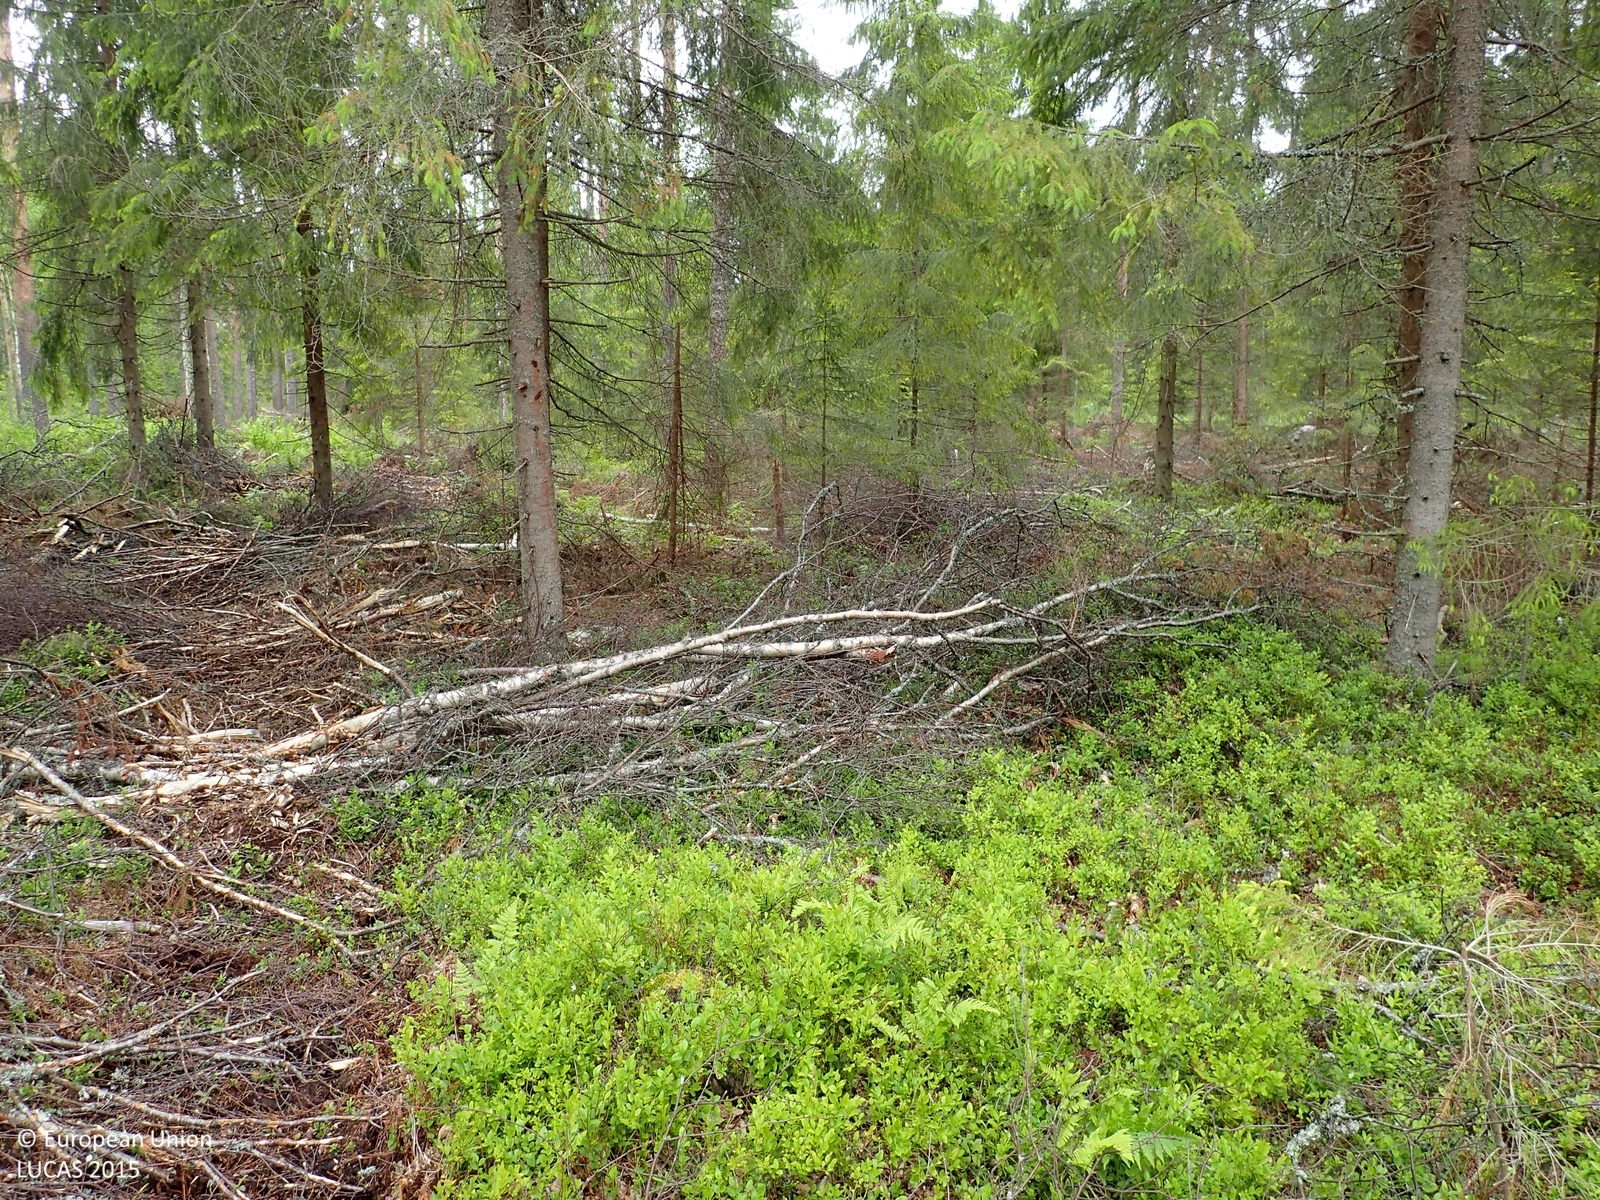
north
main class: Woodland
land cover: Spruce dominated coniferous woodland
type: boreal forest
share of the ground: 25 - 50 %
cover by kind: shrubs 55 %, coniferous forest trees 45 %
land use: Forestry
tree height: > 5 m
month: June
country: FI
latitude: 62.3735
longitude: 21.7030
